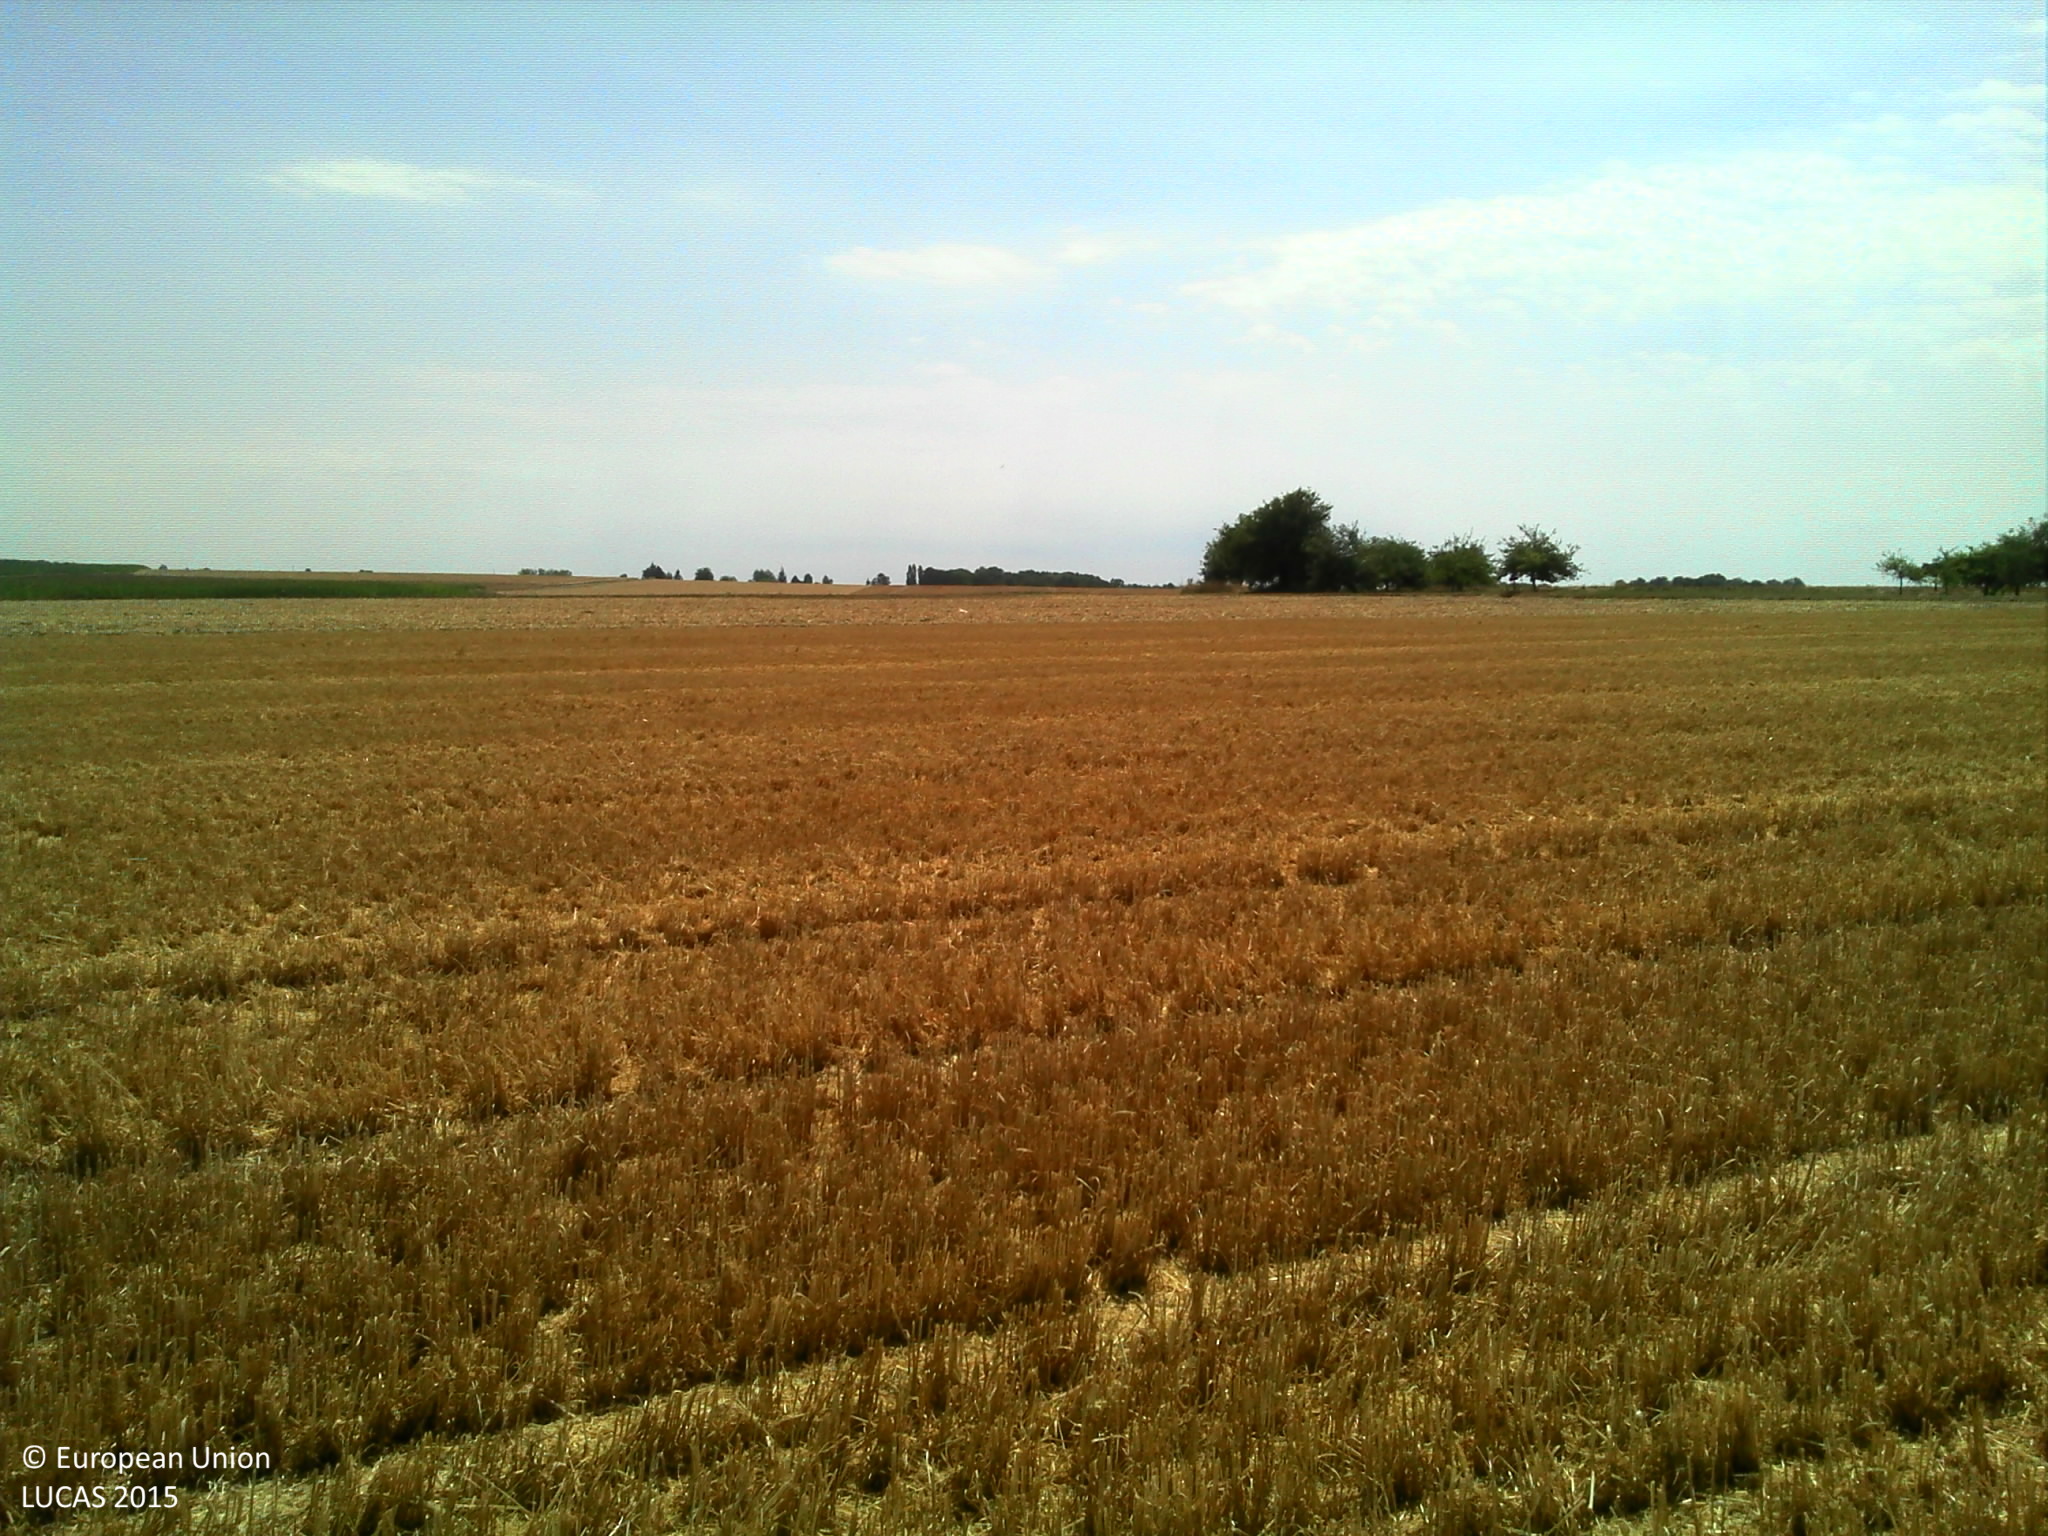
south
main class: Cropland
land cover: Barley
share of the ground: > 75 %
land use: Agriculture (excluding fallow land and kitchen gardens)
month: August
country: FR
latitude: 48.8339
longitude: 3.3309
